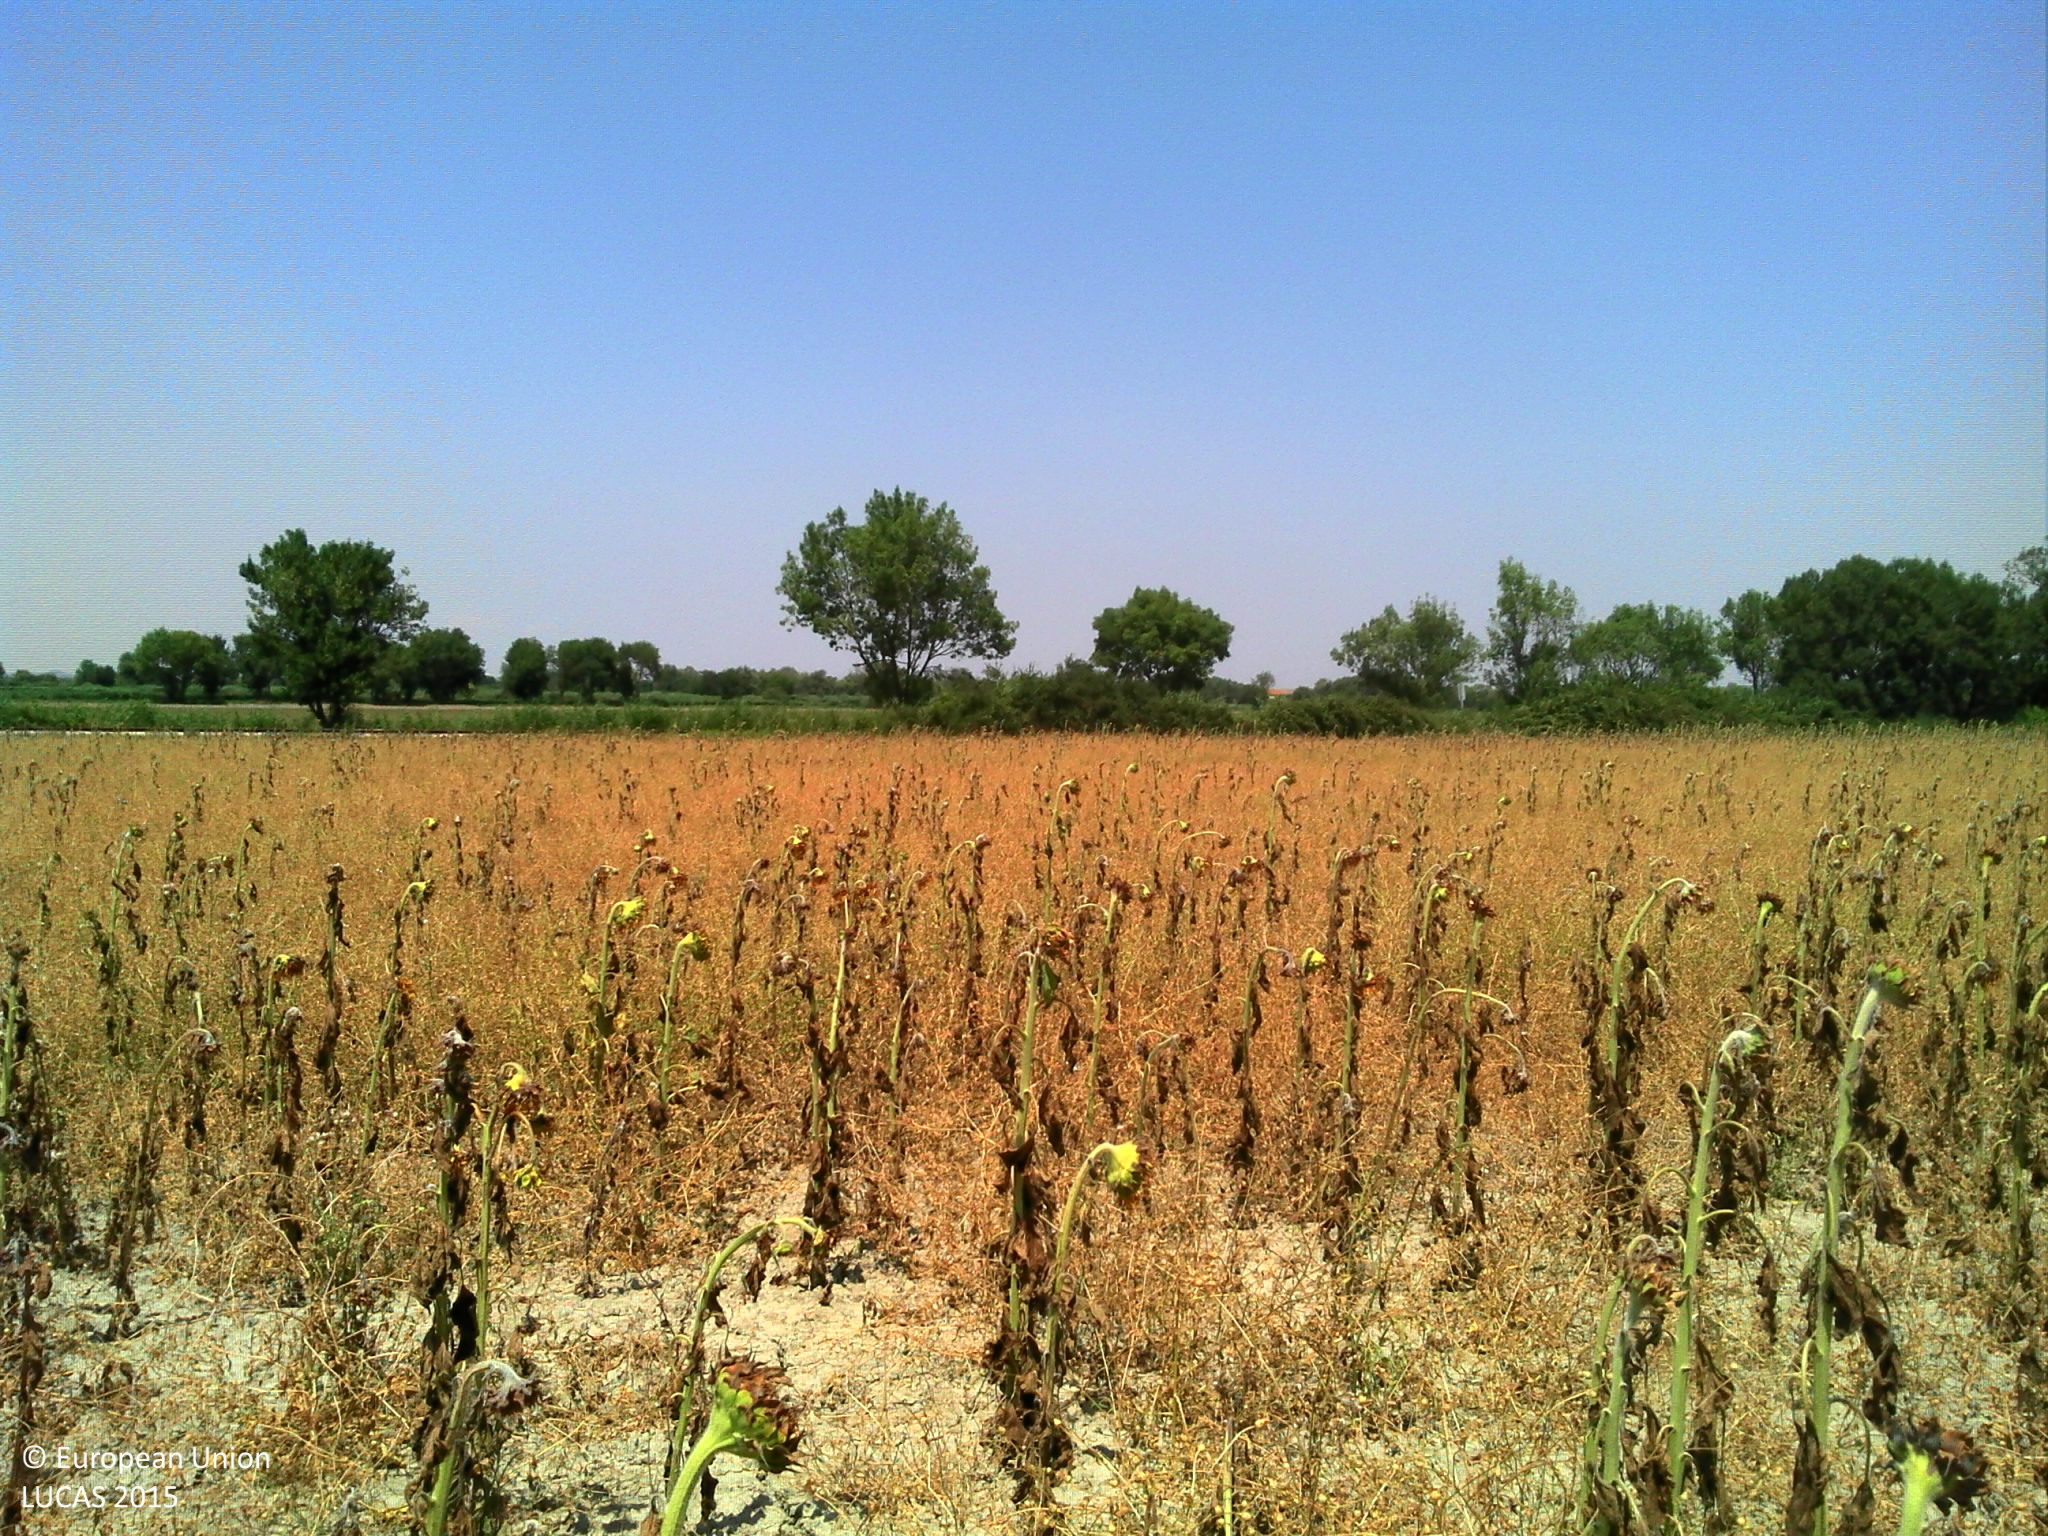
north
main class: Cropland
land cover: Sunflower
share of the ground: 25 - 50 %
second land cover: Spontaneously vegetated surfaces
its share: 25 - 50 %
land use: Agriculture (excluding fallow land and kitchen gardens)
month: July
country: FR
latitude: 43.7070
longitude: 4.6606
